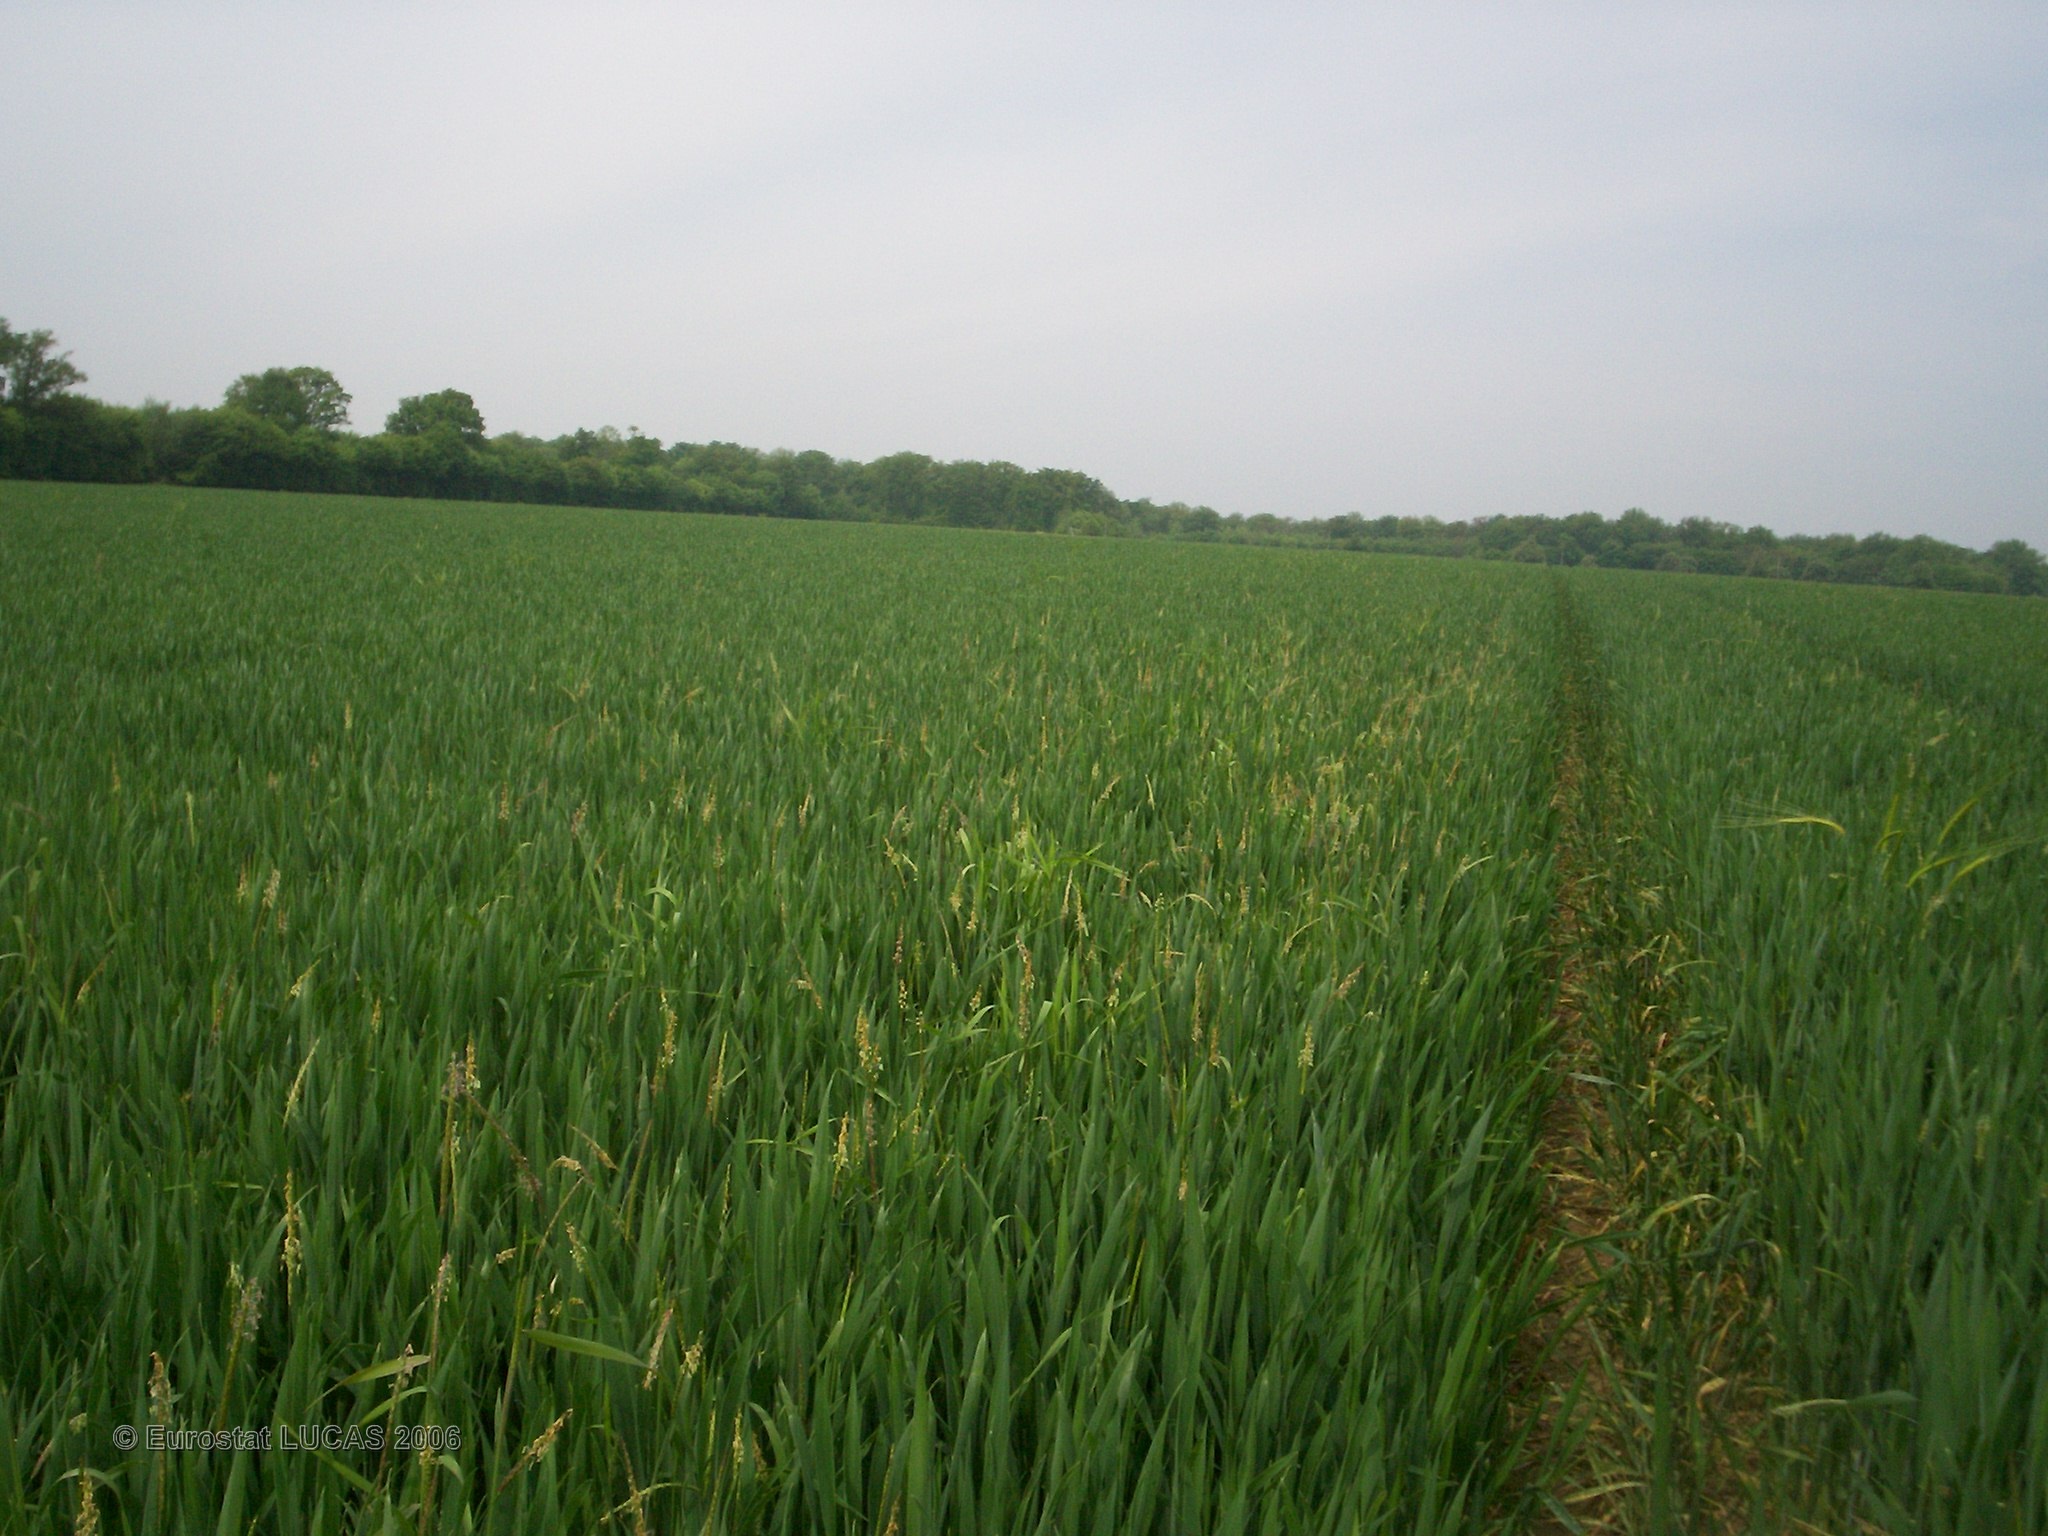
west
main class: Cropland
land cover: Common wheat
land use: Agriculture (excluding fallow land and kitchen gardens)
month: May
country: FR
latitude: 47.7637
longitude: 2.9622
